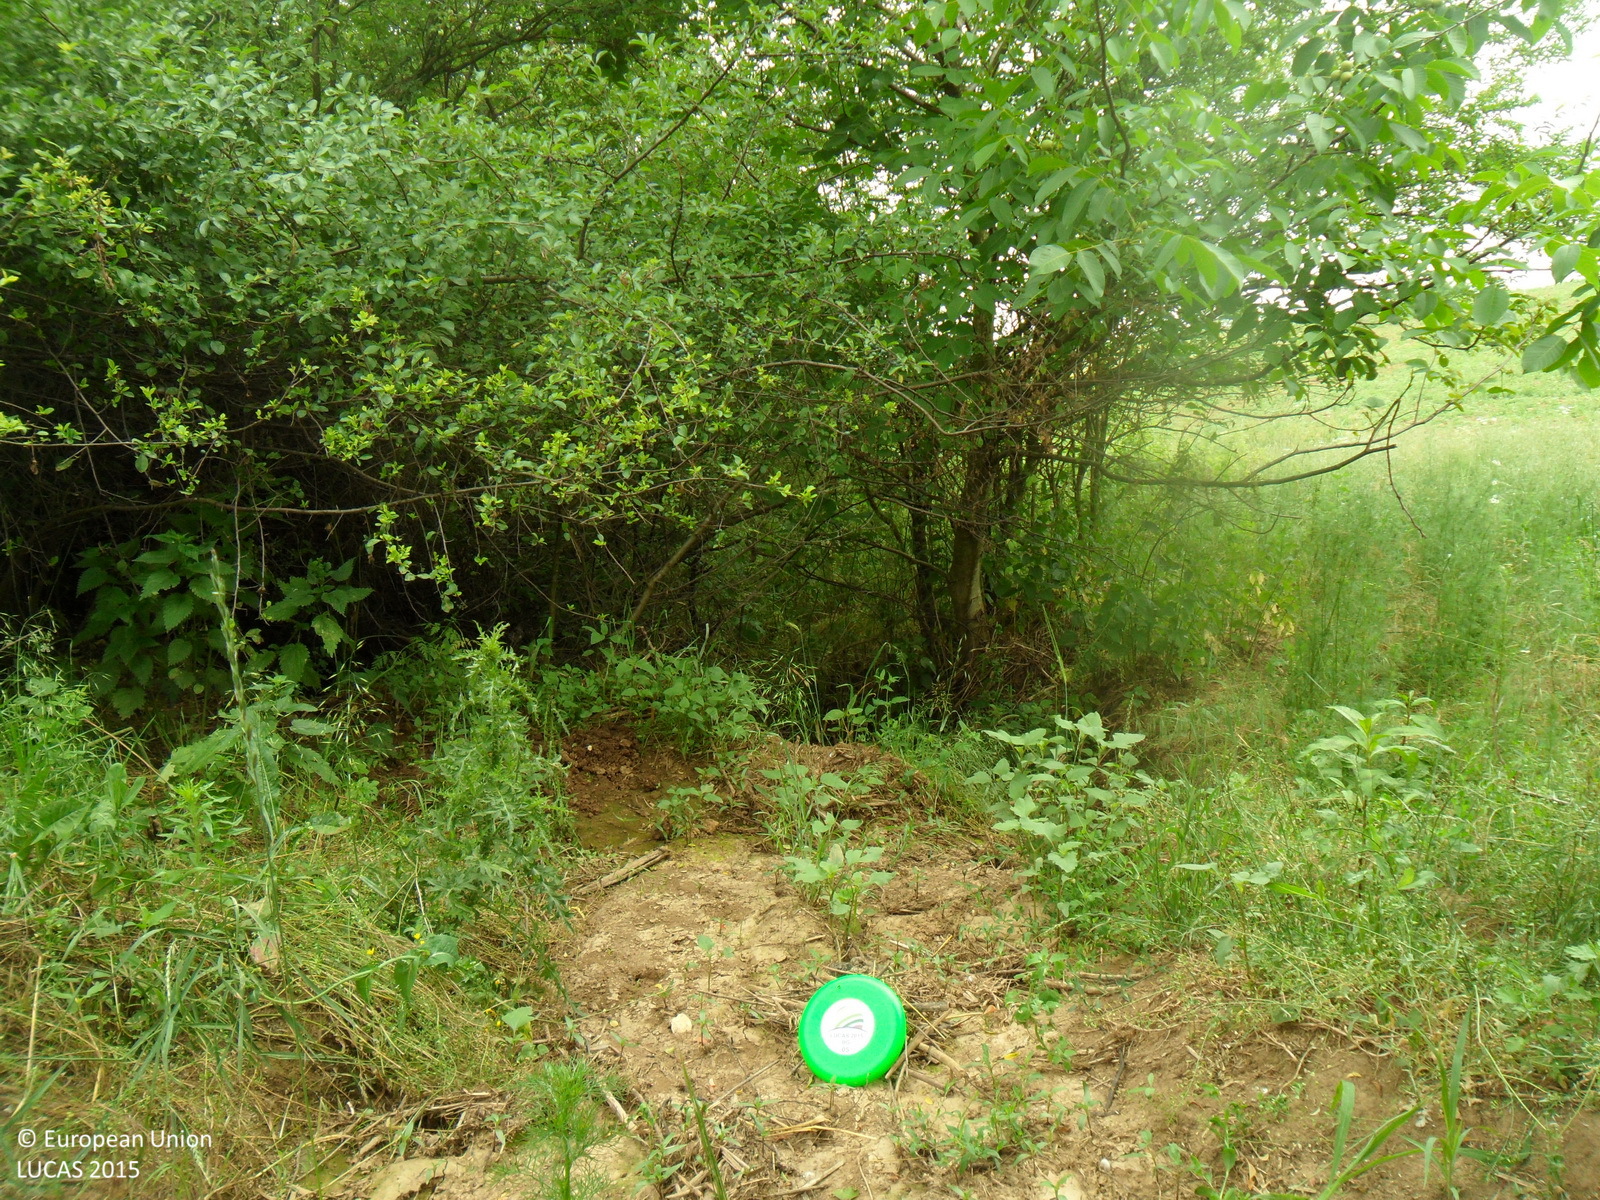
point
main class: Cropland
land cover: Other fruit trees and berries
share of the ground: > 75 %
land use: Agriculture (excluding fallow land and kitchen gardens)
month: June
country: BG
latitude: 43.7078
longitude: 26.7809
